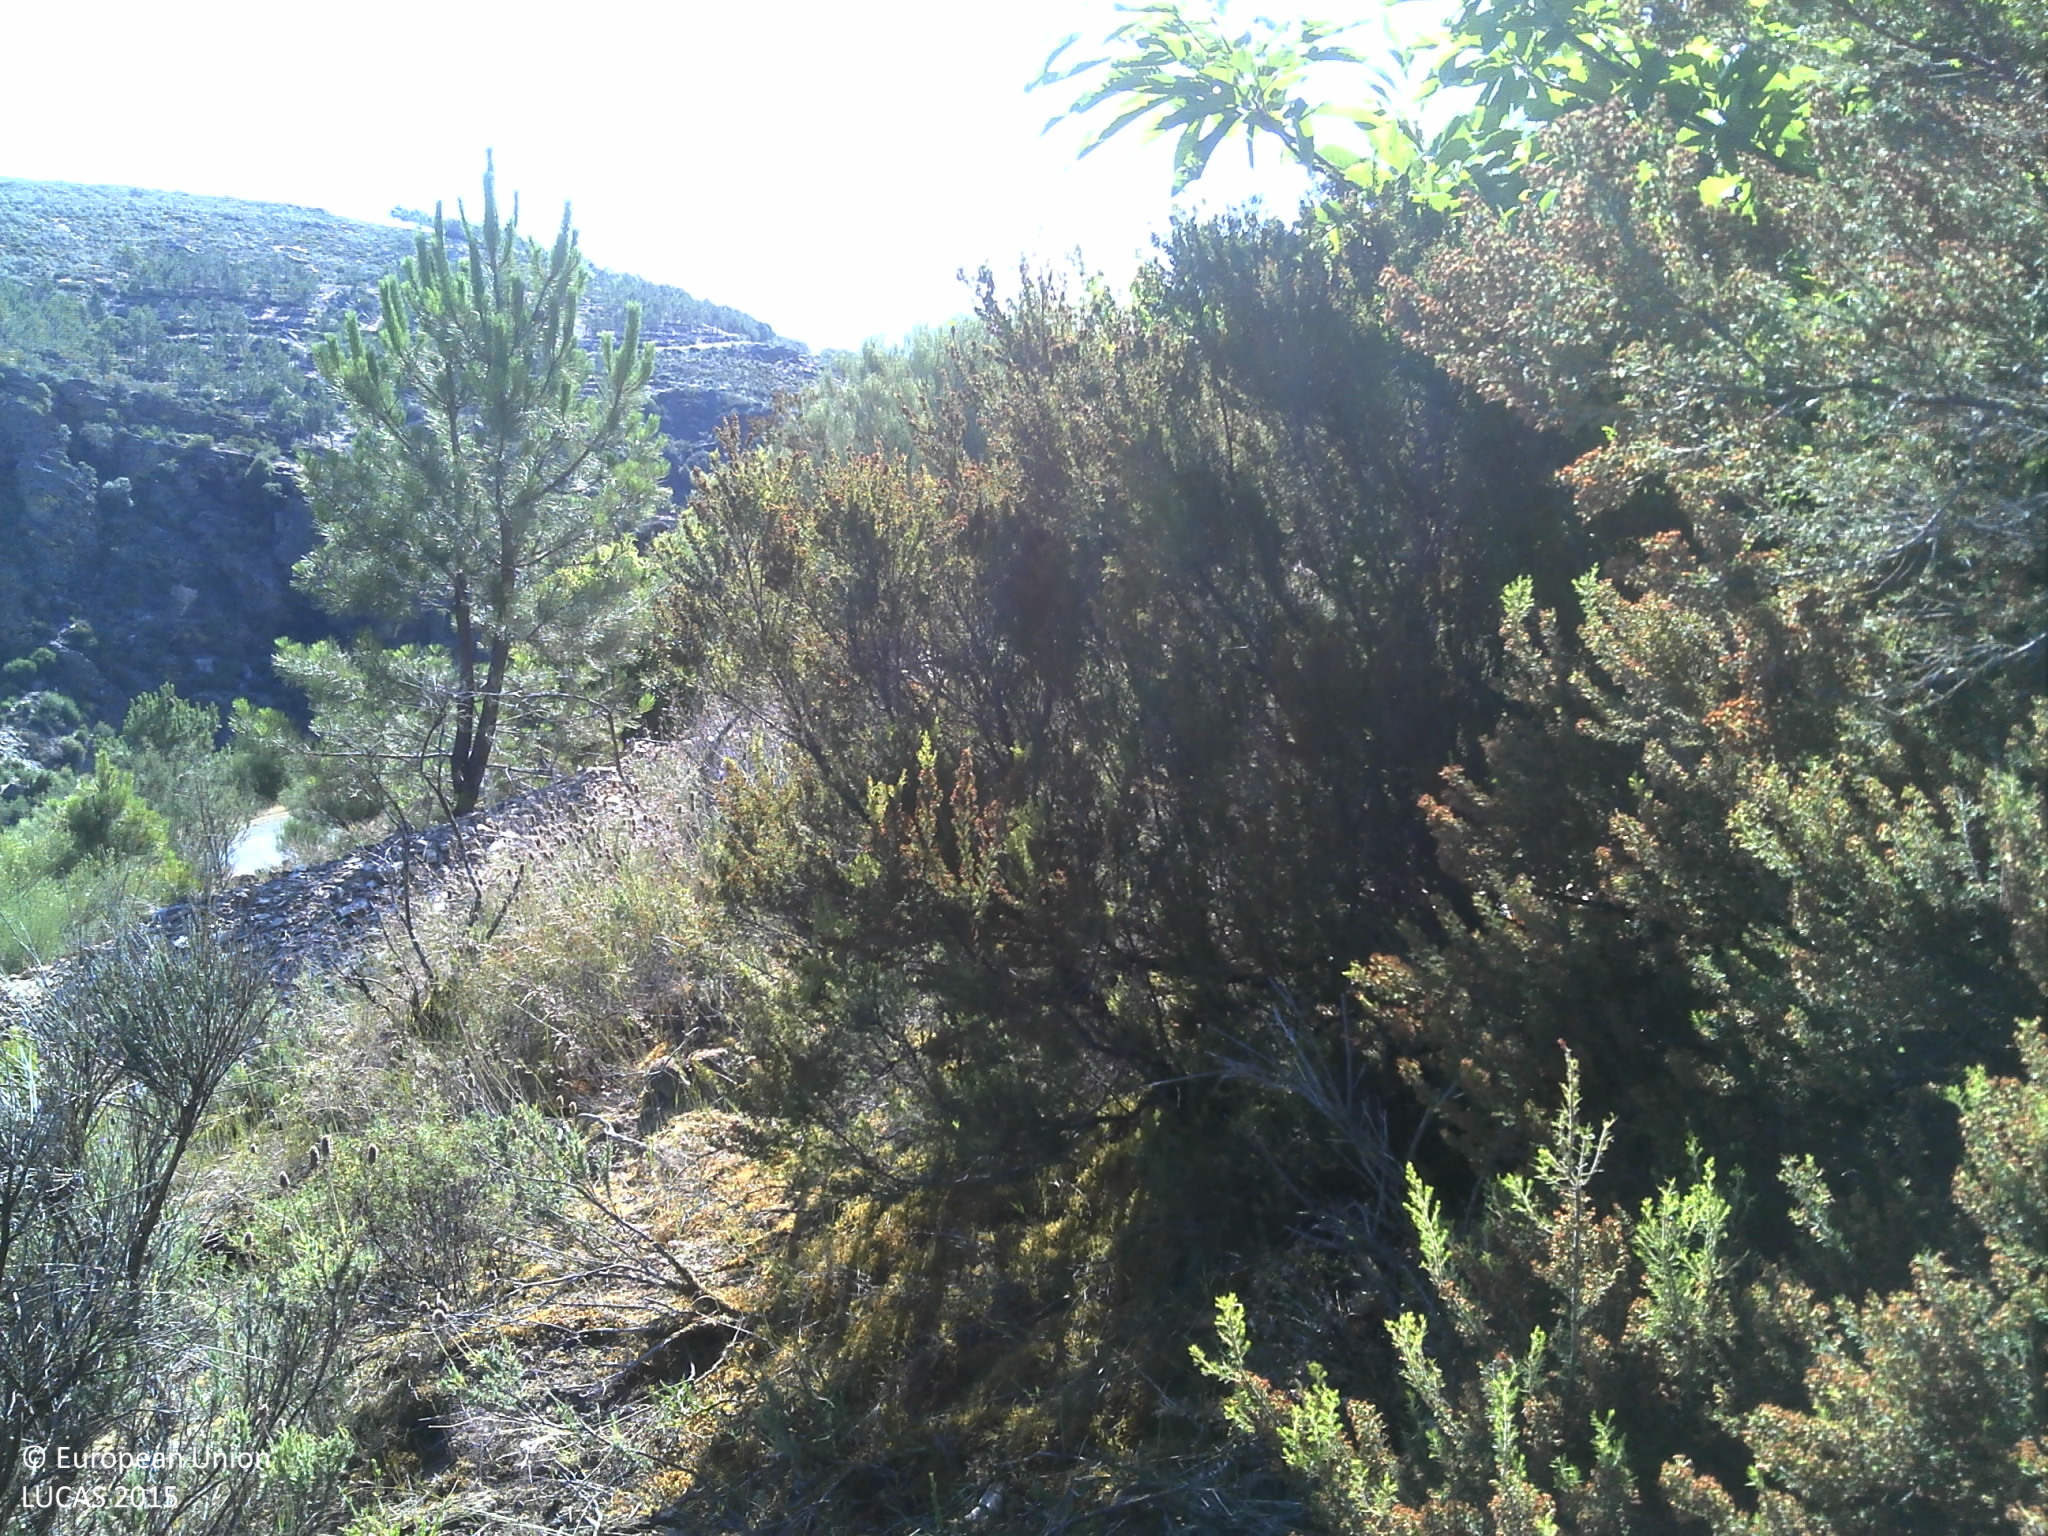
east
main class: Woodland
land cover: Broadleaved woodland
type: thermophilous deciduous forest
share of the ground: 10 - 25 %
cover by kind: shrubs 85 %, broadleaved forest trees 15 %
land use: Forestry
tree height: < 5 m
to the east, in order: Broadleaved woodland; Shrubland without tree cover; Broadleaved woodland; Tracks; Shrubland with sparse tree cover; Rock outcrops; Paved roads, cycling and walking lanes; Shrubland without tree cover; Rock outcrops
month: June
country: PT
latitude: 41.4381
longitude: -6.9270
